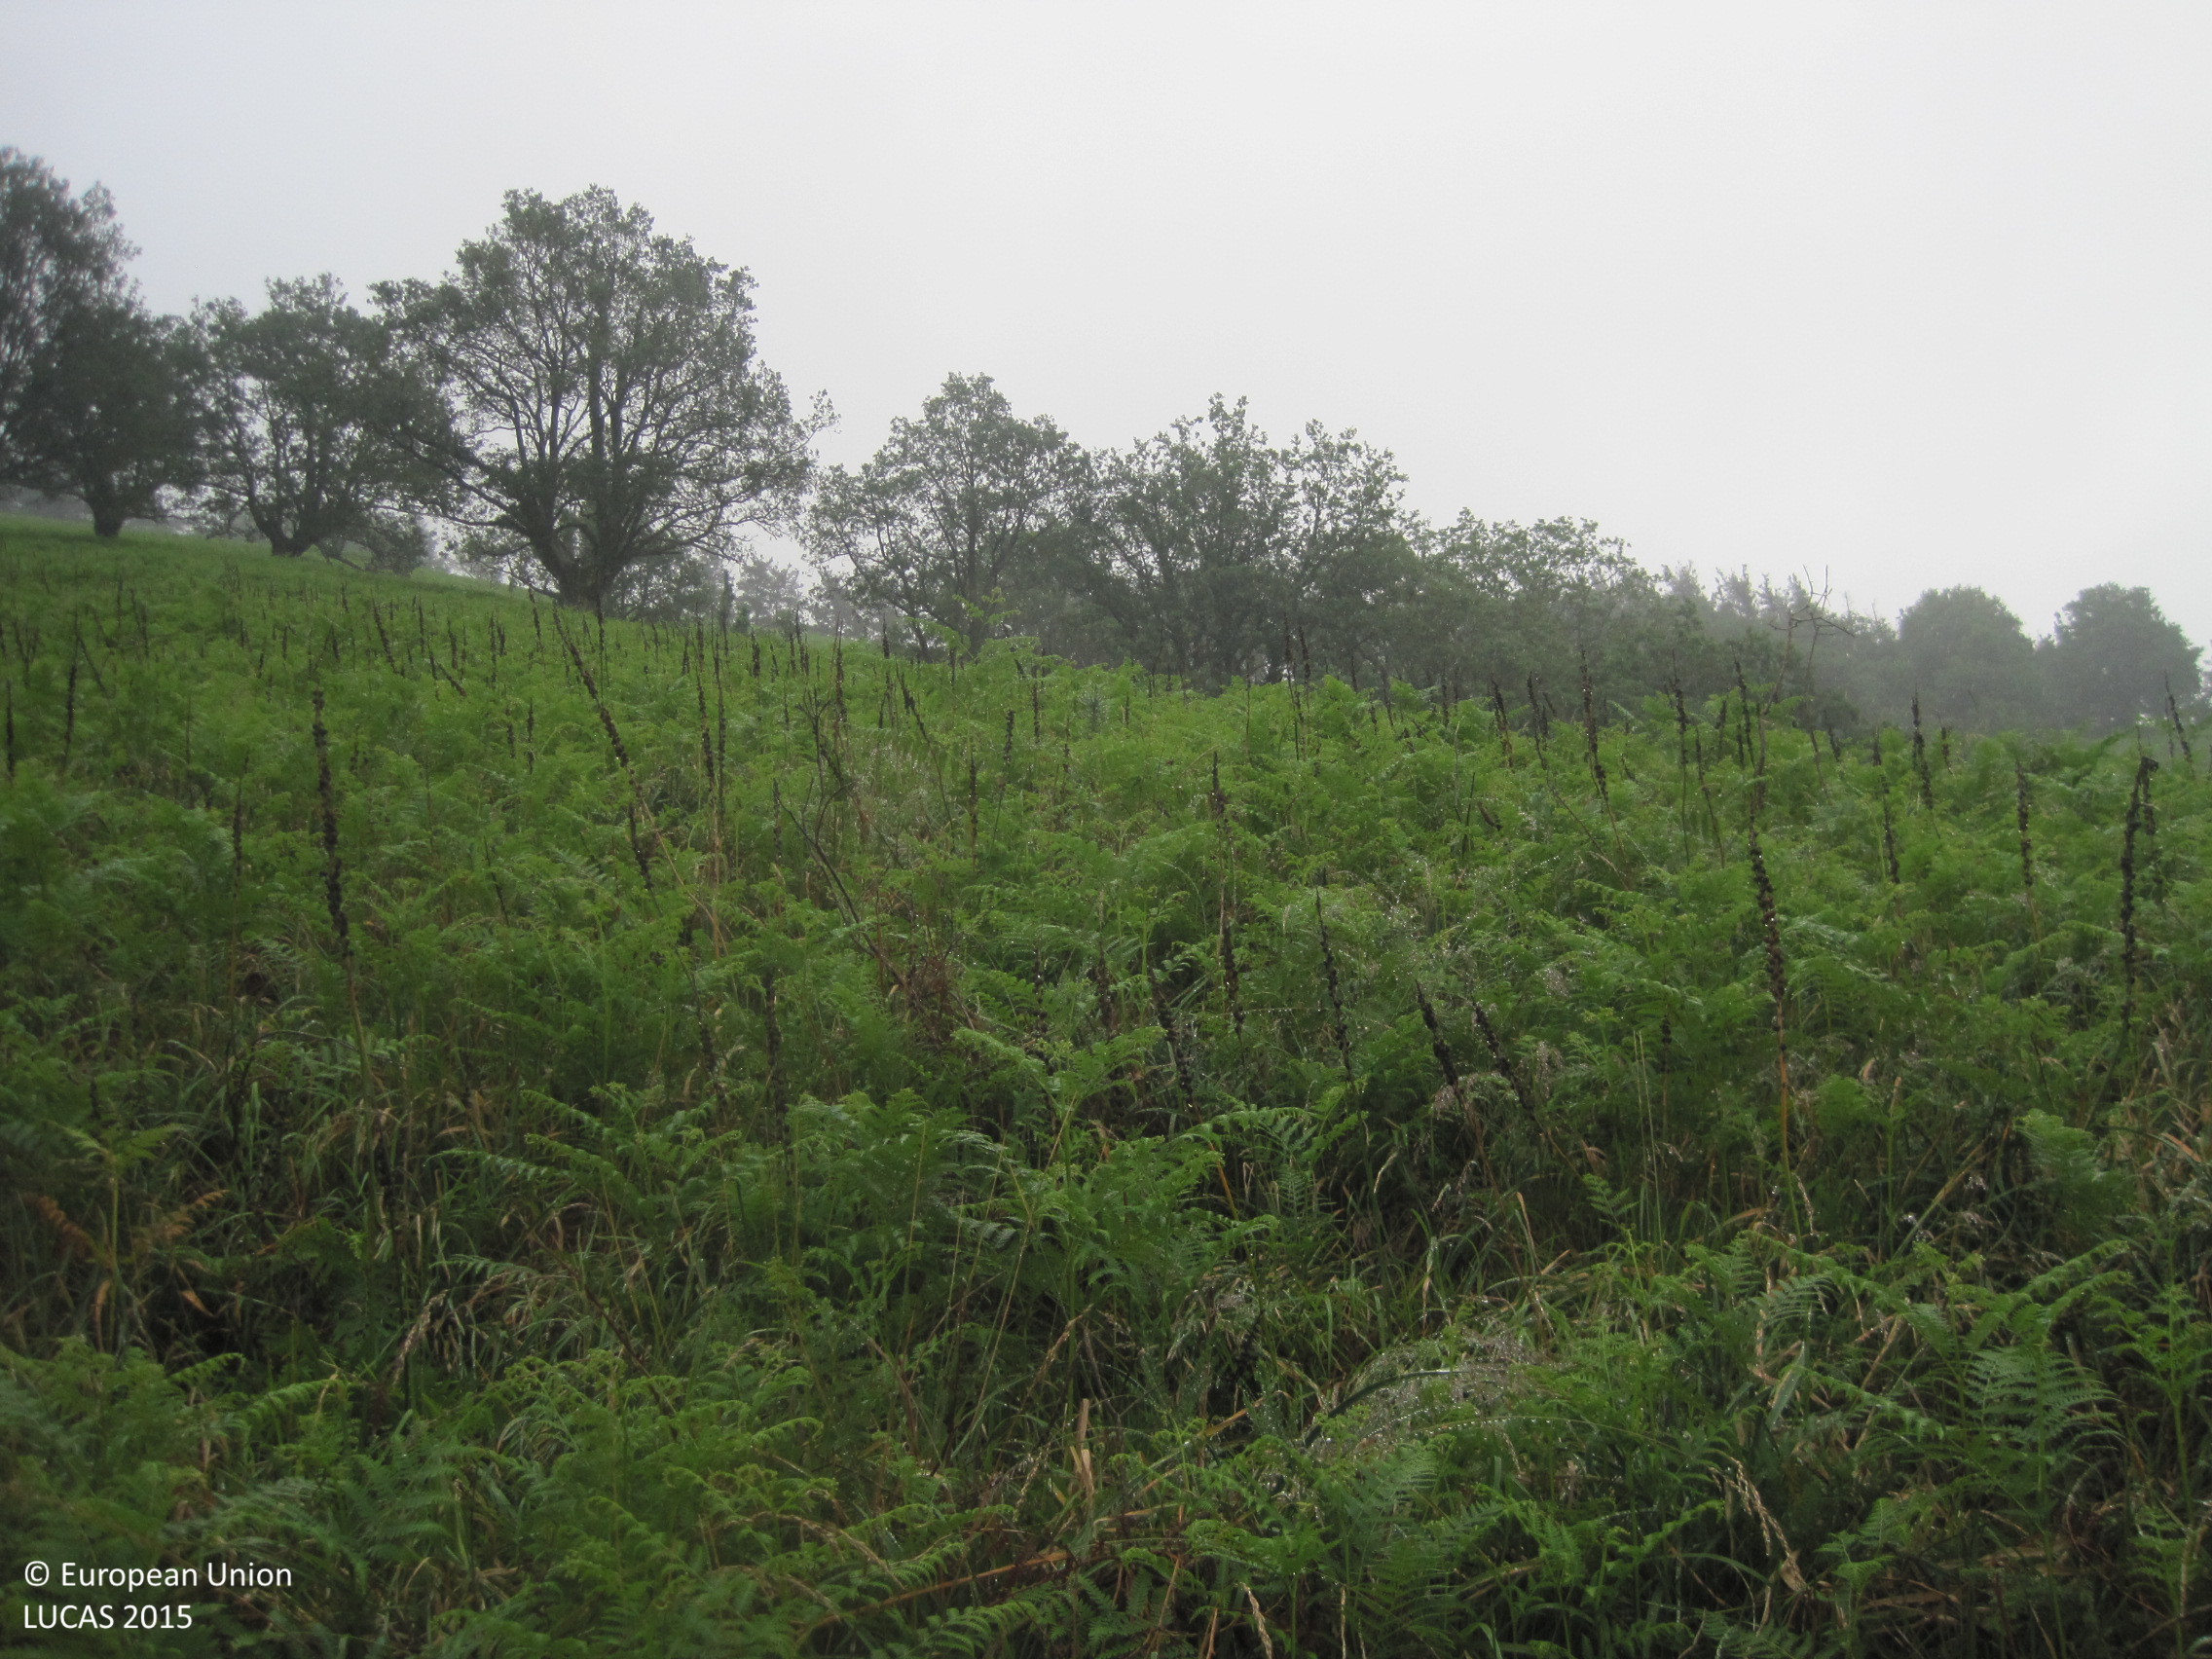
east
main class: Grassland
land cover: Grassland without tree/shrub cover
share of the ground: > 75 %
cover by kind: herbaceous plants 100 %
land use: Agriculture (excluding fallow land and kitchen gardens)
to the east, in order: Grassland without tree/shrub cover; Broadleaved woodland; Grassland without tree/shrub cover; Pine dominated coniferous woodland
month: June
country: ES
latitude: 43.1958
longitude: -1.8459
